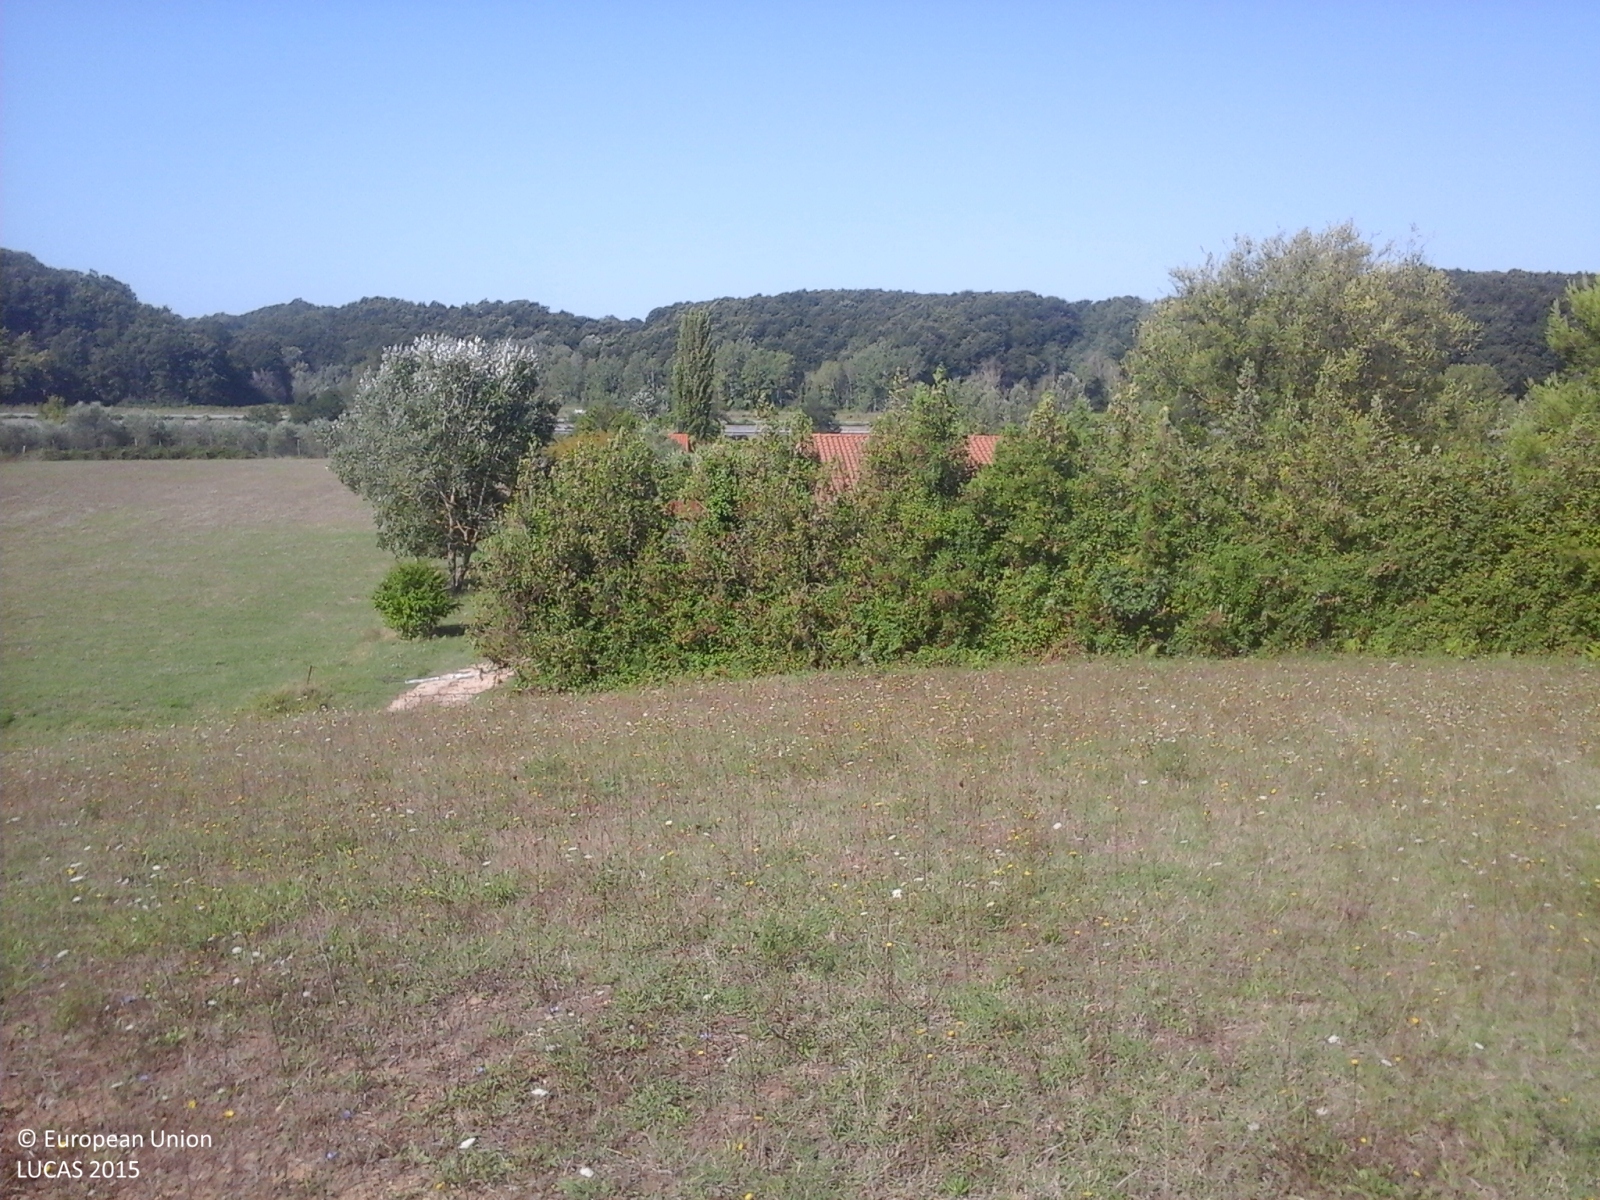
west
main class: Grassland
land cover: Grassland without tree/shrub cover
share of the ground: > 75 %
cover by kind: herbaceous plants 100 %
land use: Agriculture (excluding fallow land and kitchen gardens)
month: August
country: IT
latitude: 43.5918
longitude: 10.4570
